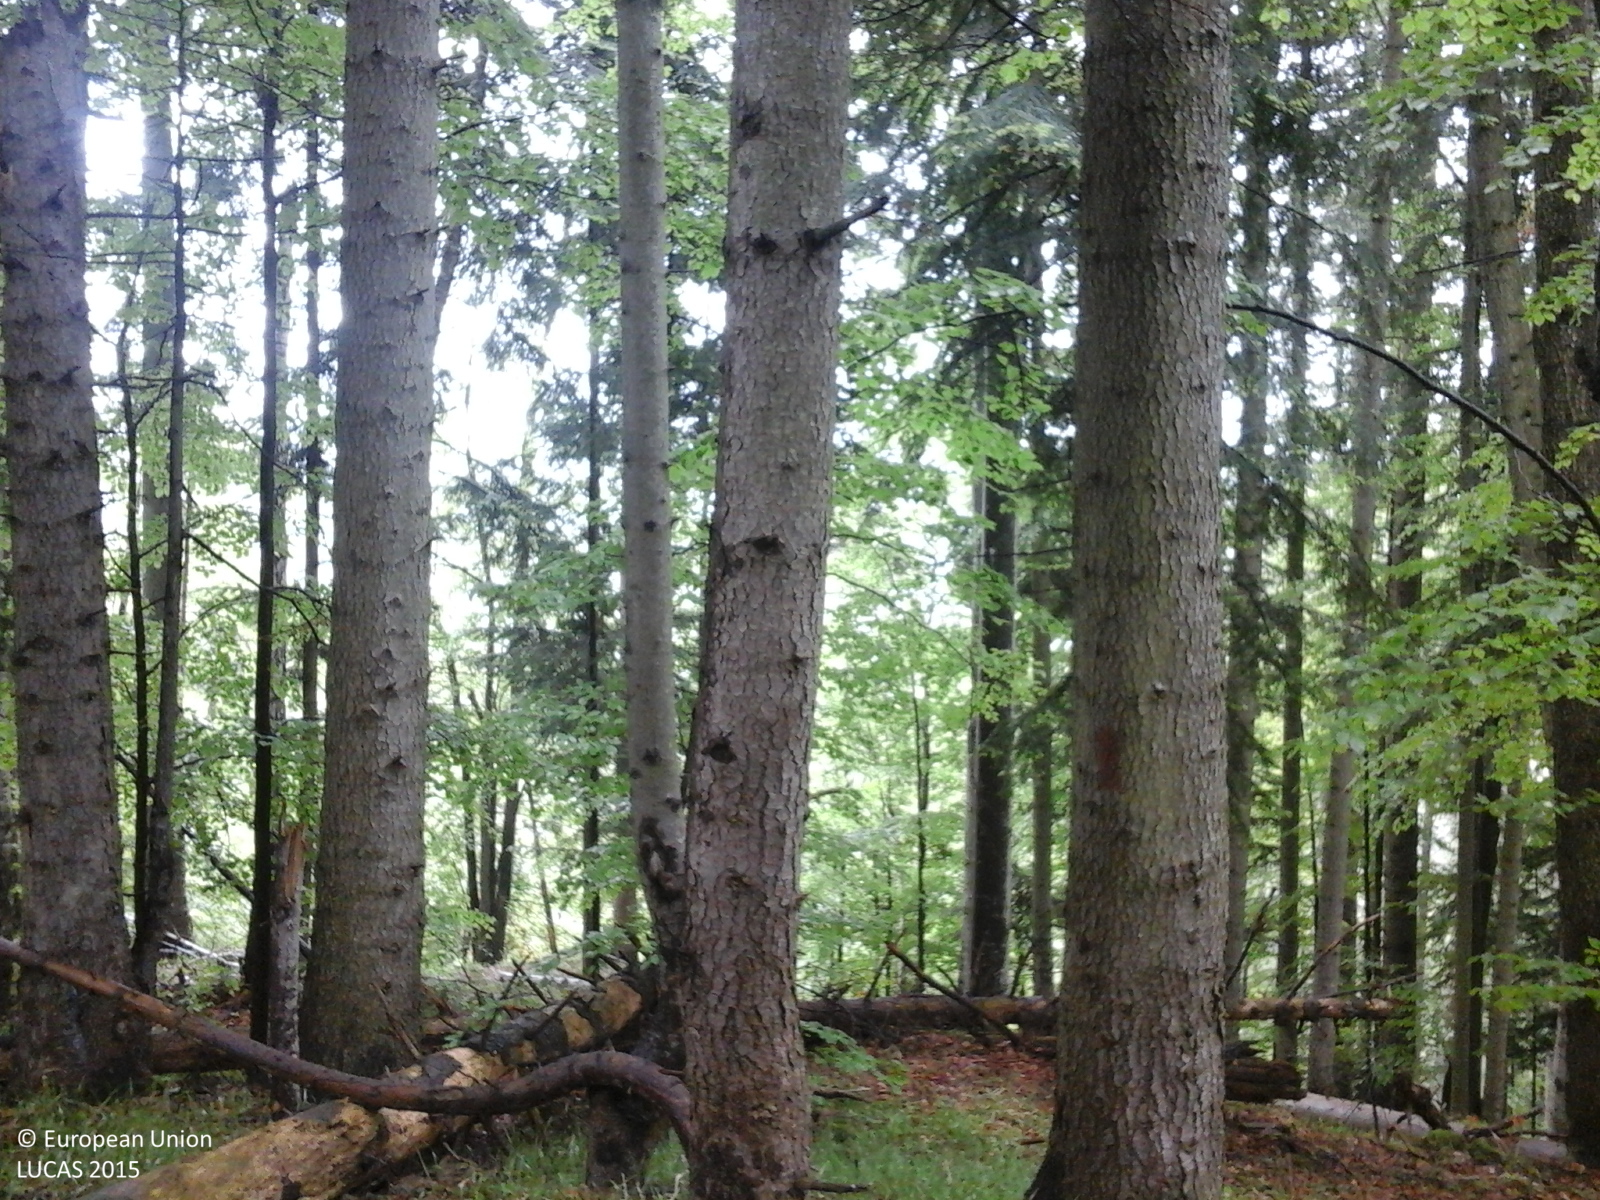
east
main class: Woodland
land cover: Other mixed woodland
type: alpine coniferous forest
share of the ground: > 75 %
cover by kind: coniferous forest trees 65 %, broadleaved forest trees 35 %
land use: Forestry
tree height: > 5 m
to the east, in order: Other mixed woodland
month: May
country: RO
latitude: 45.6385
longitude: 25.2213
